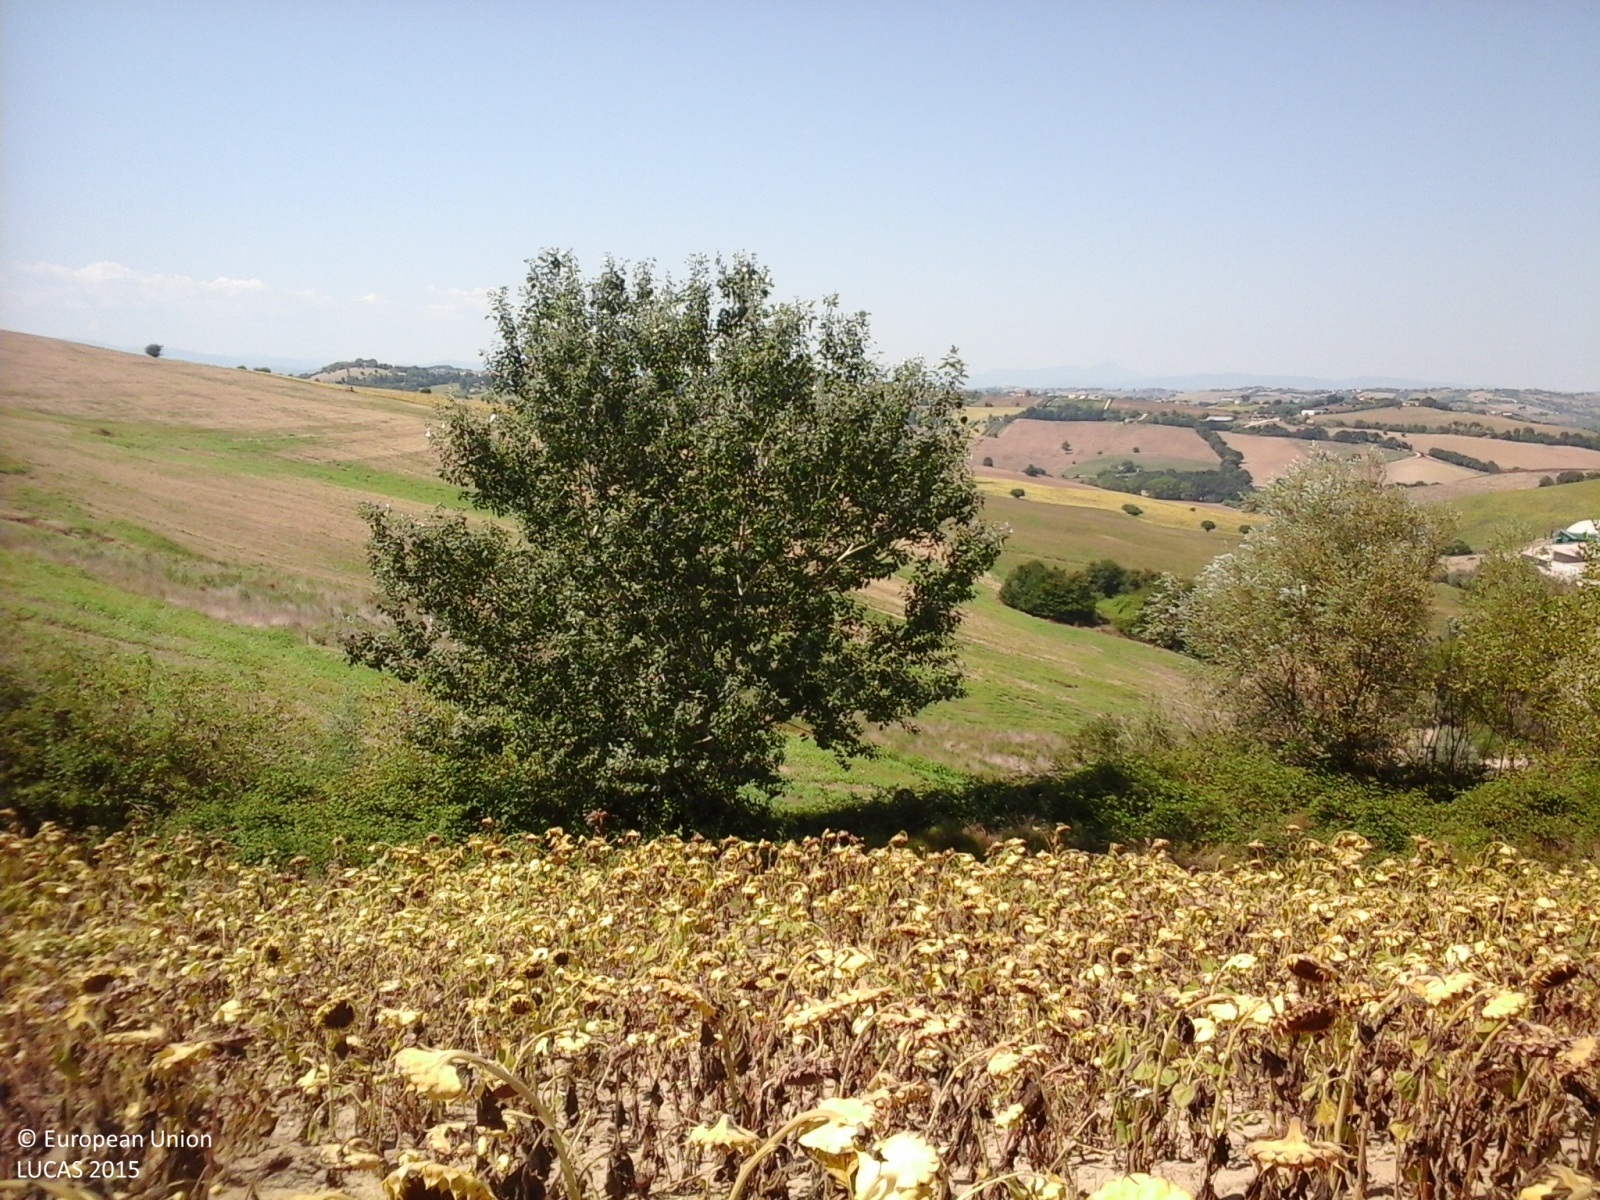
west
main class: Cropland
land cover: Sunflower
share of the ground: > 75 %
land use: Agriculture (excluding fallow land and kitchen gardens)
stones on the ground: < 10 %
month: August
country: IT
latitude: 43.1849
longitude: 13.6447
